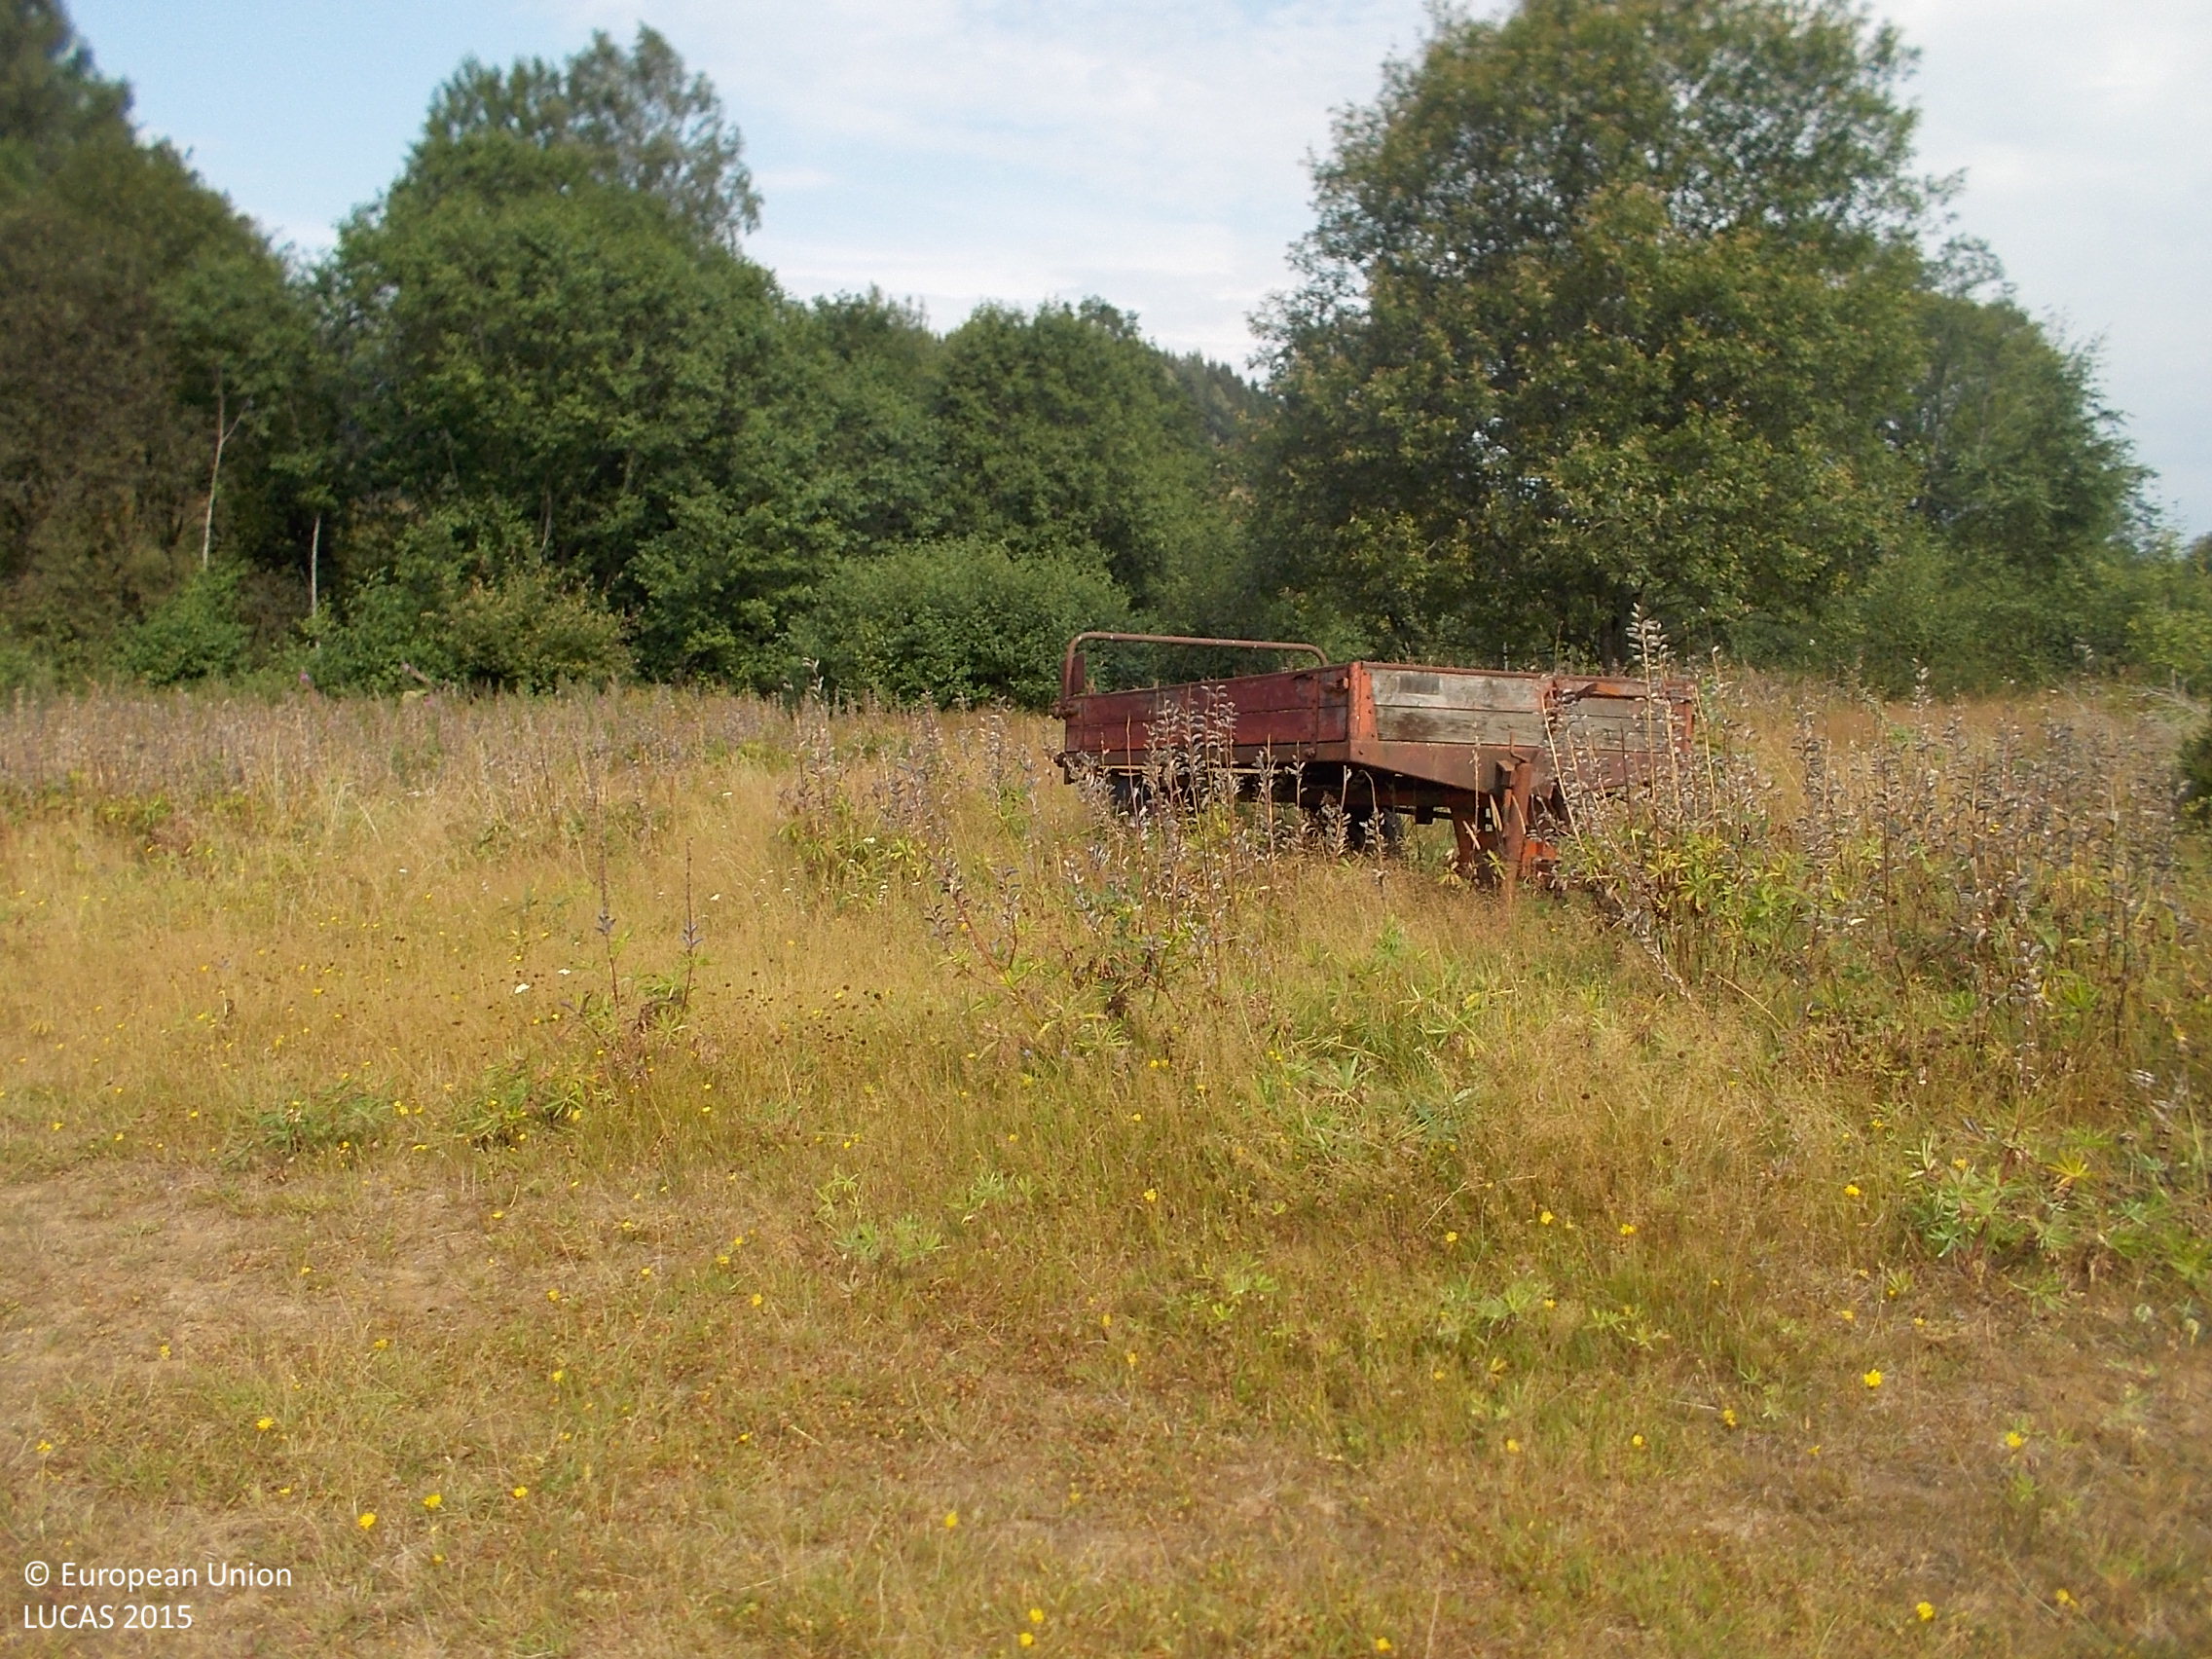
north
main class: Grassland
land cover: Grassland without tree/shrub cover
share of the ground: > 75 %
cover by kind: herbaceous plants 100 %
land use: Agriculture (excluding fallow land and kitchen gardens)
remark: Harvested field
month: August
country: SE
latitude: 57.3925
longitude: 13.0740
